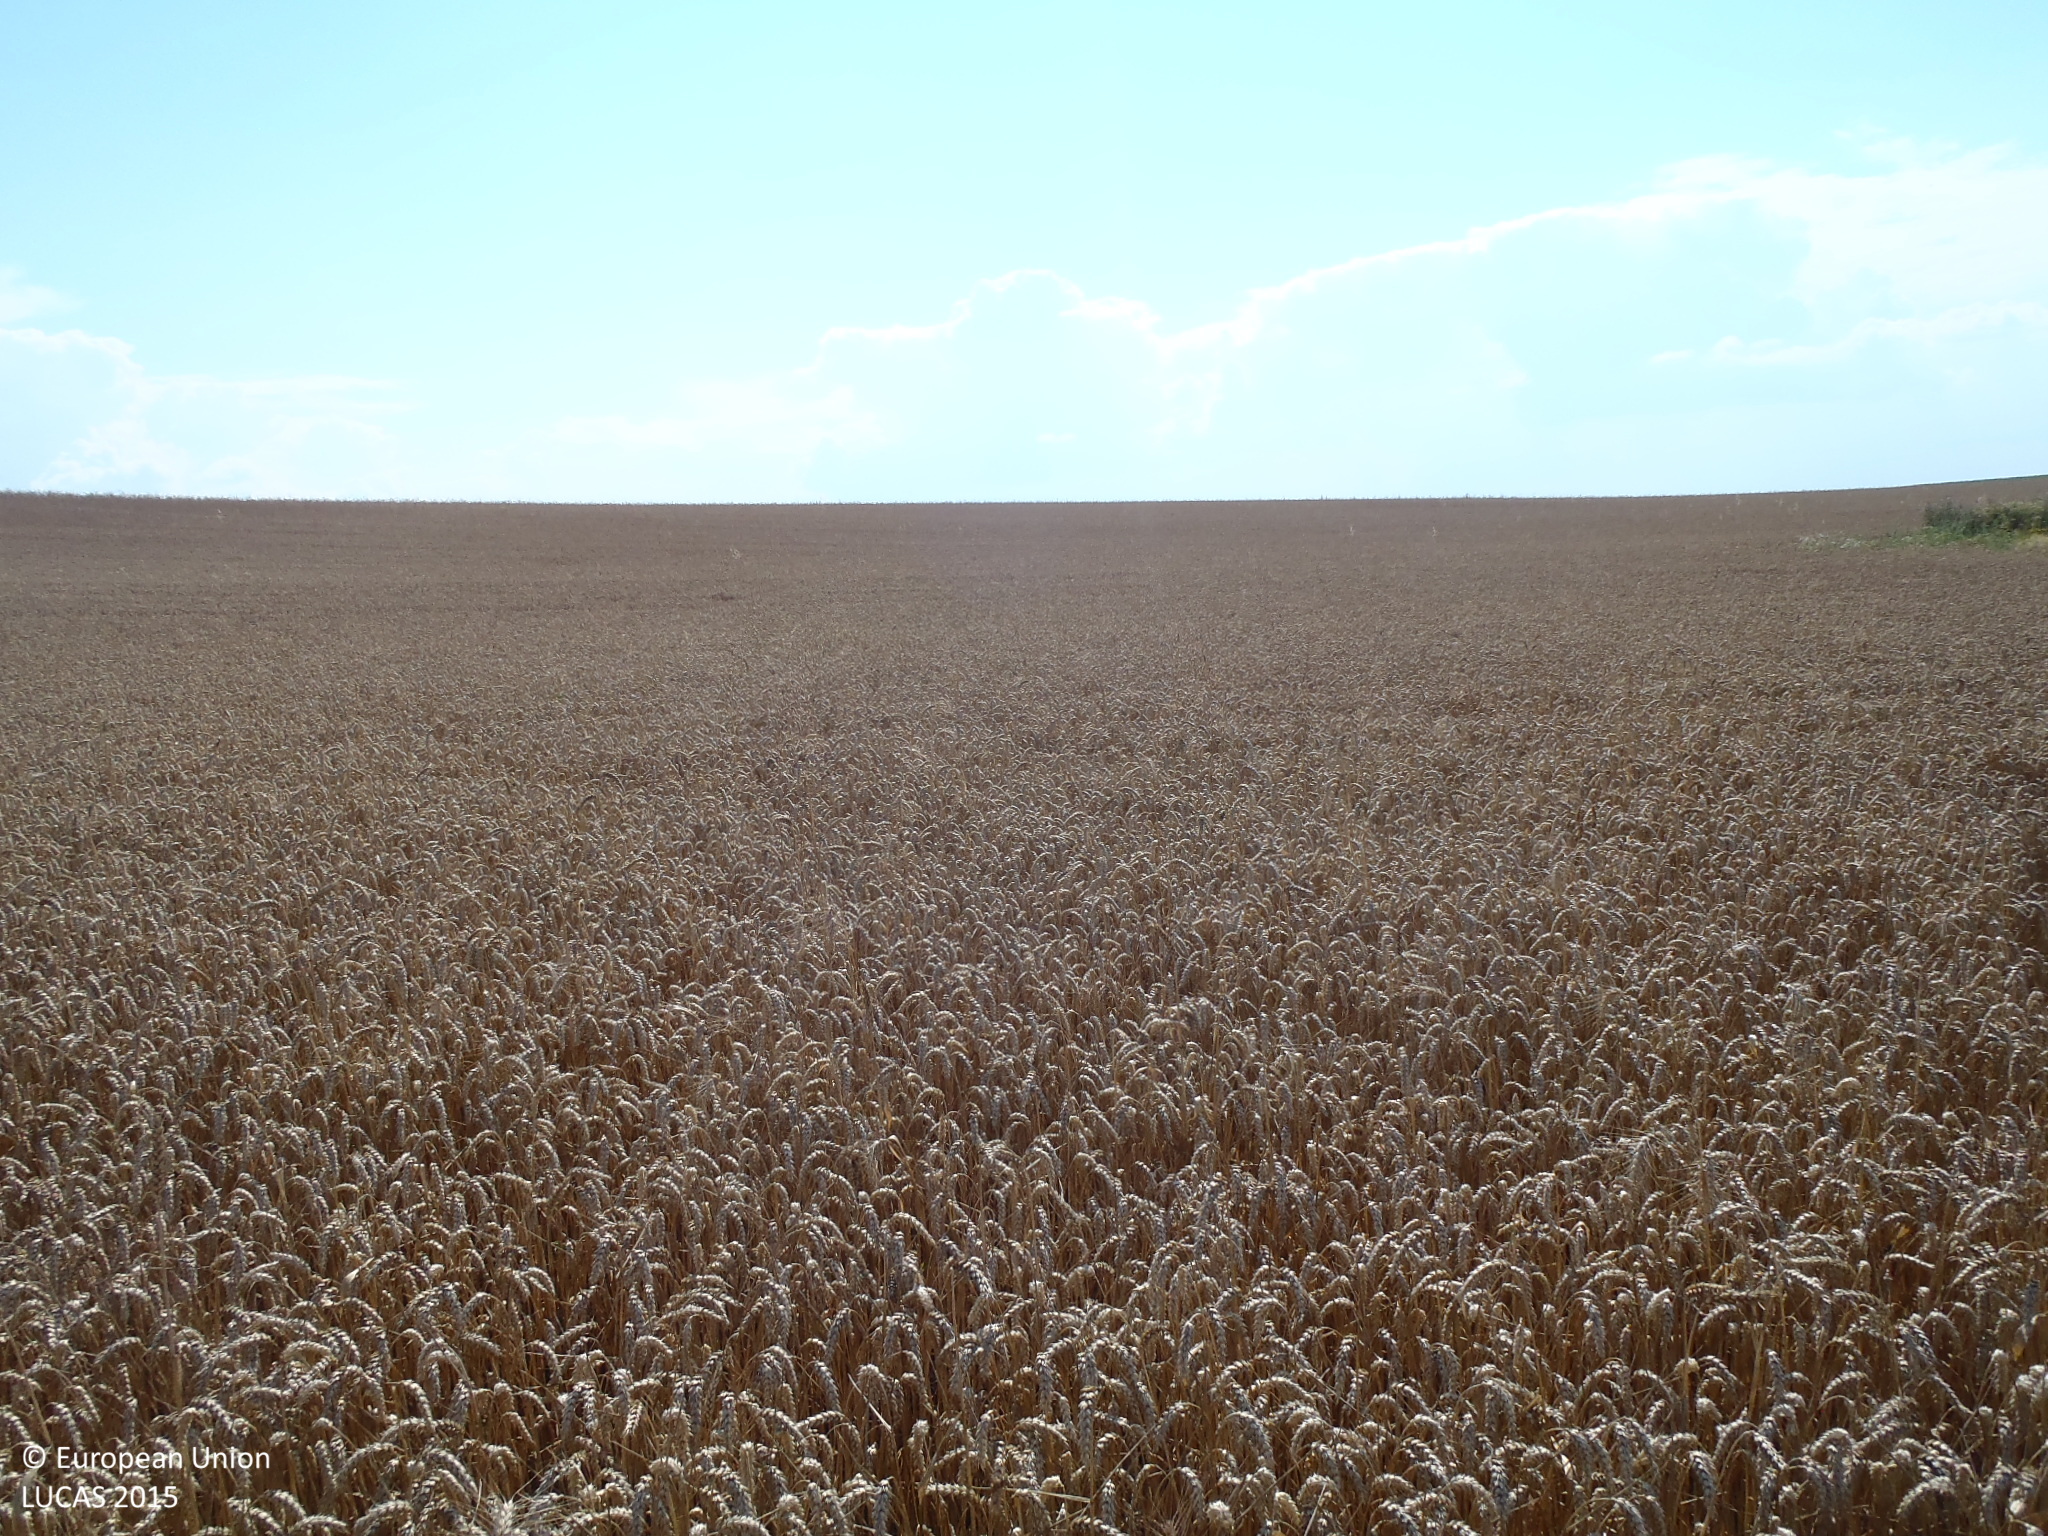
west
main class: Cropland
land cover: Common wheat
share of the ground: > 75 %
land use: Agriculture (excluding fallow land and kitchen gardens)
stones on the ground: < 10 %
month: July
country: BG
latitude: 43.9528
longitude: 26.2915
